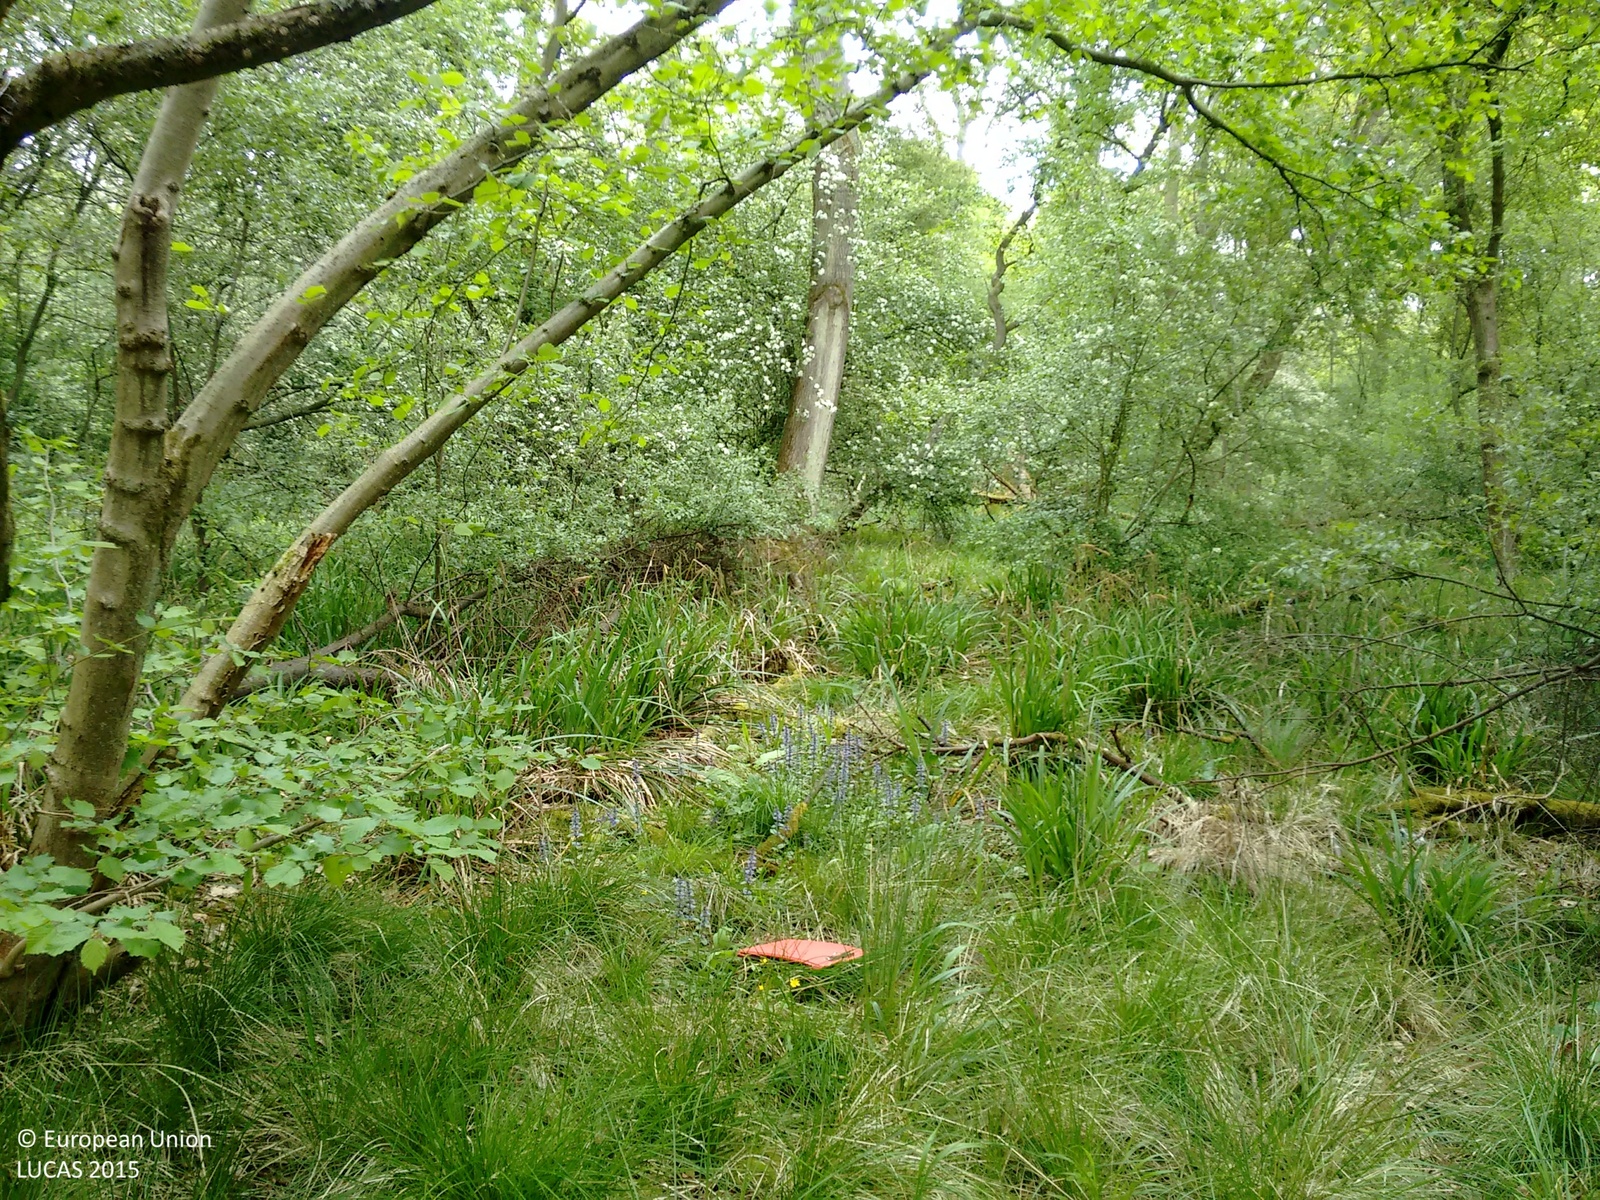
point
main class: Woodland
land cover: Broadleaved woodland
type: mesophytic deciduous forest
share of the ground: > 75 %
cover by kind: broadleaved forest trees 100 %
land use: Community services
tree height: > 5 m
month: May
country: GB
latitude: 52.0660
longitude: -0.5859
